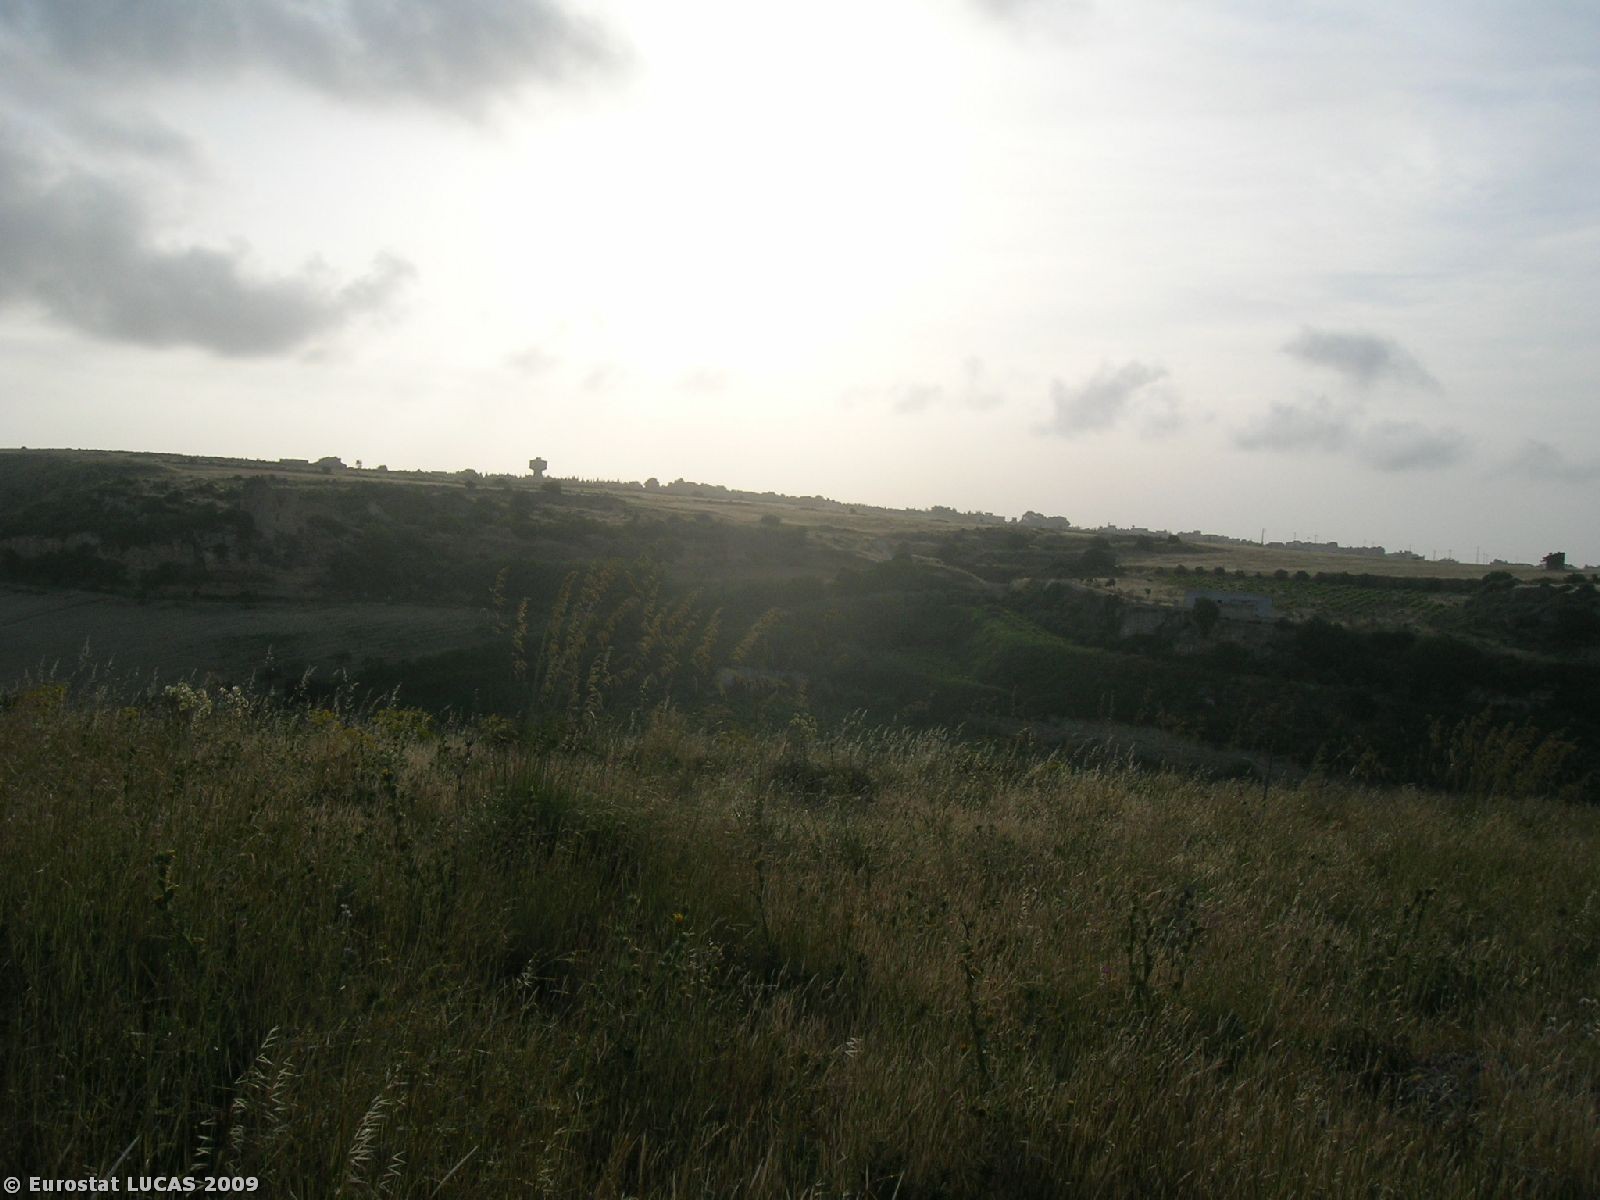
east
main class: Shrubland
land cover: Shrubland without tree cover
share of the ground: > 75 %
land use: Nature reserves
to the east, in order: Shrubland without tree cover; Permanent crops (only in case pi); Bare land; Shrubland without tree cover; Inland running water; Broadleaved woodland; Grass margins; Vineyards; Bare land
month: May
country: IT
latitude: 37.7114
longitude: 12.6232
